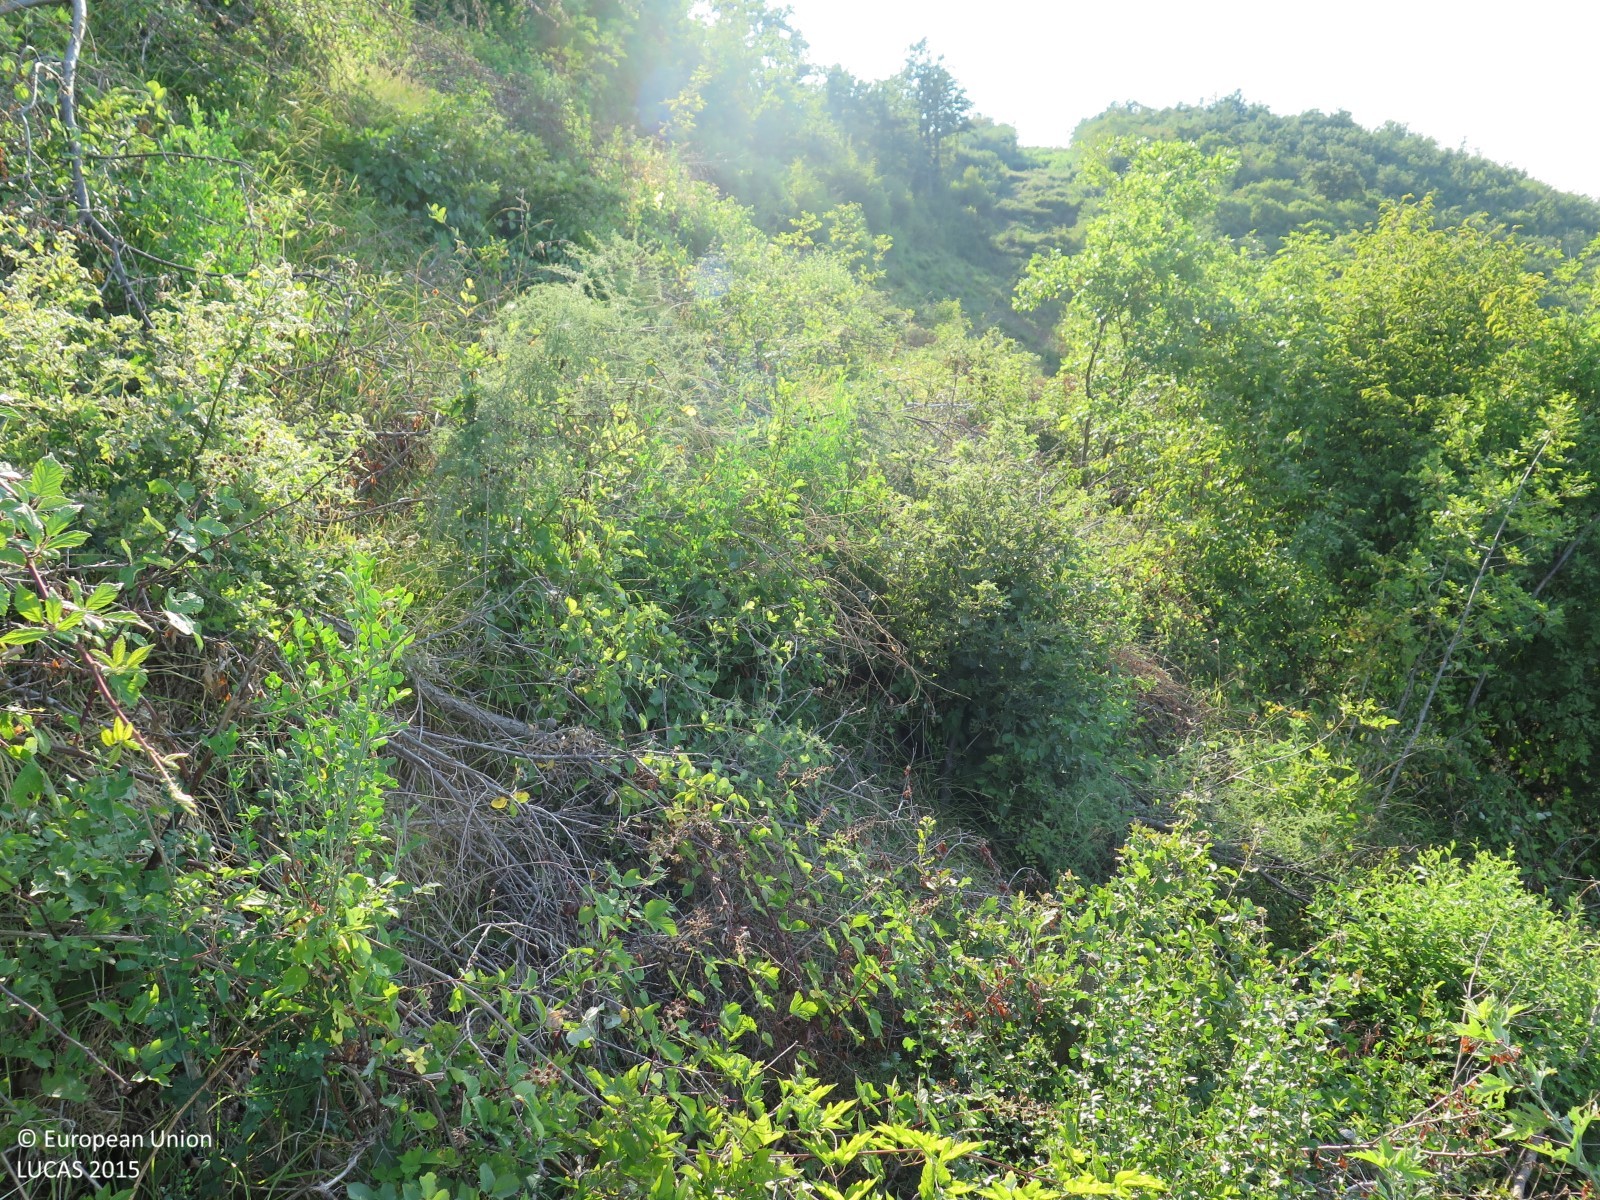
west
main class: Woodland
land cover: Broadleaved woodland
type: acidophilous oak and oak-birch forest
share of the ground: > 75 %
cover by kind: broadleaved forest trees 90 %, shrubs 5 %, herbaceous plants 5 %
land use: Semi-natural and natural areas not in use
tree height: > 5 m
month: July
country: HR
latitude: 45.1920
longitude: 14.0550
